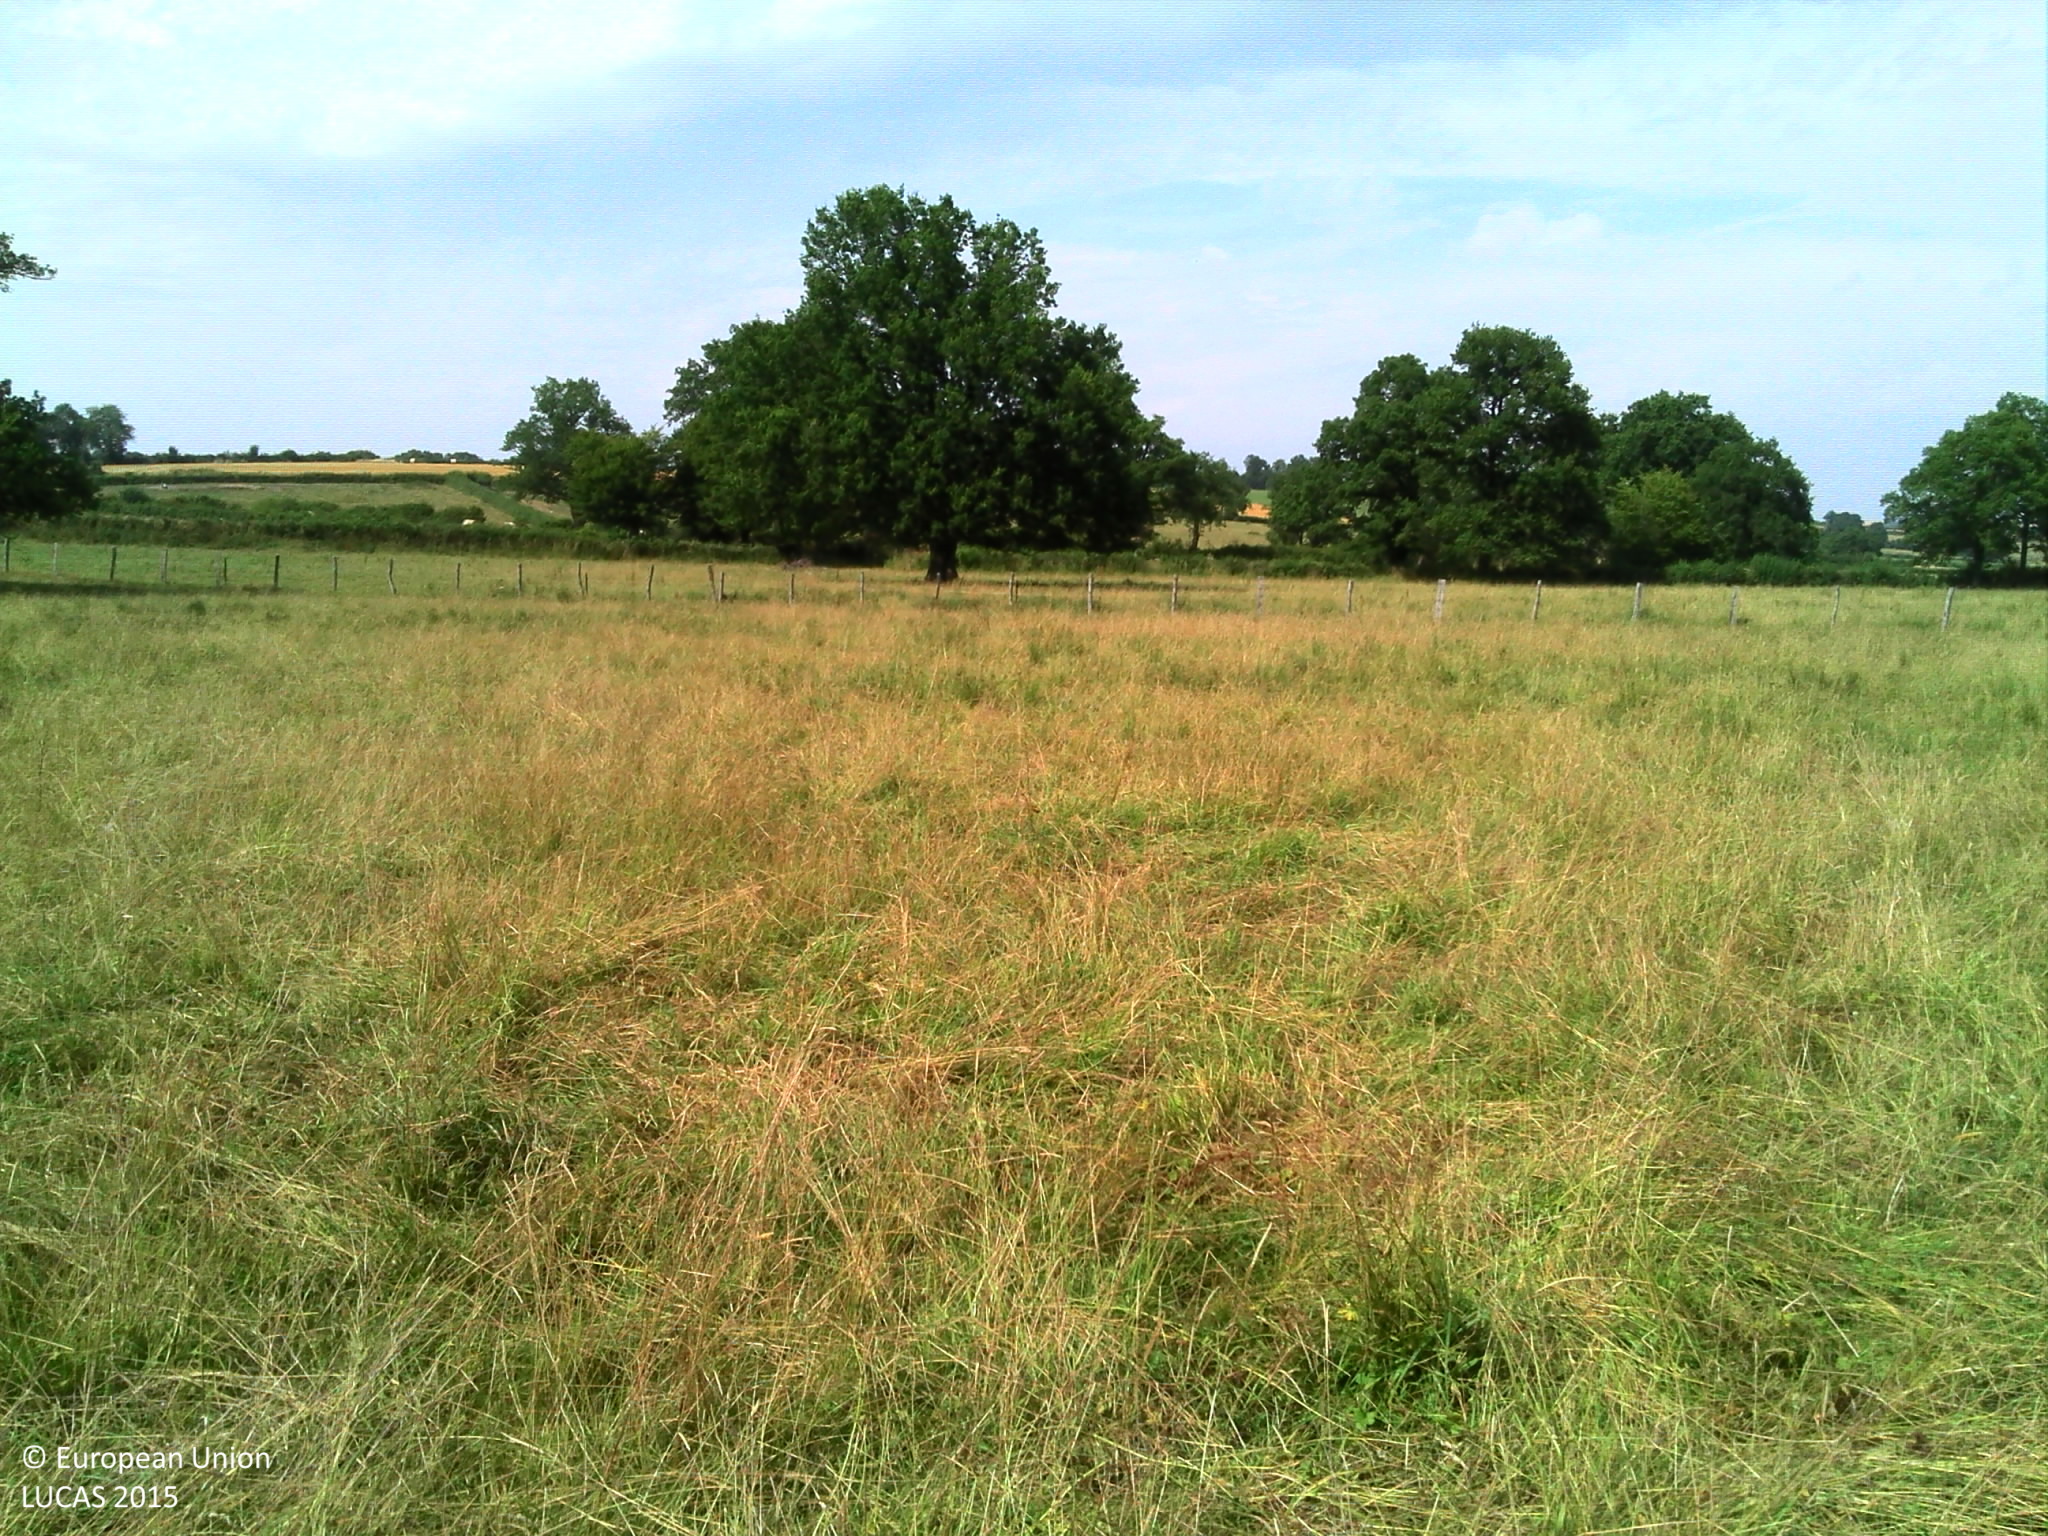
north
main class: Grassland
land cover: Grassland without tree/shrub cover
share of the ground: > 75 %
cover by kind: herbaceous plants 100 %
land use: Agriculture (excluding fallow land and kitchen gardens)
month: July
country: FR
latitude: 47.2215
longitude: 3.5394
